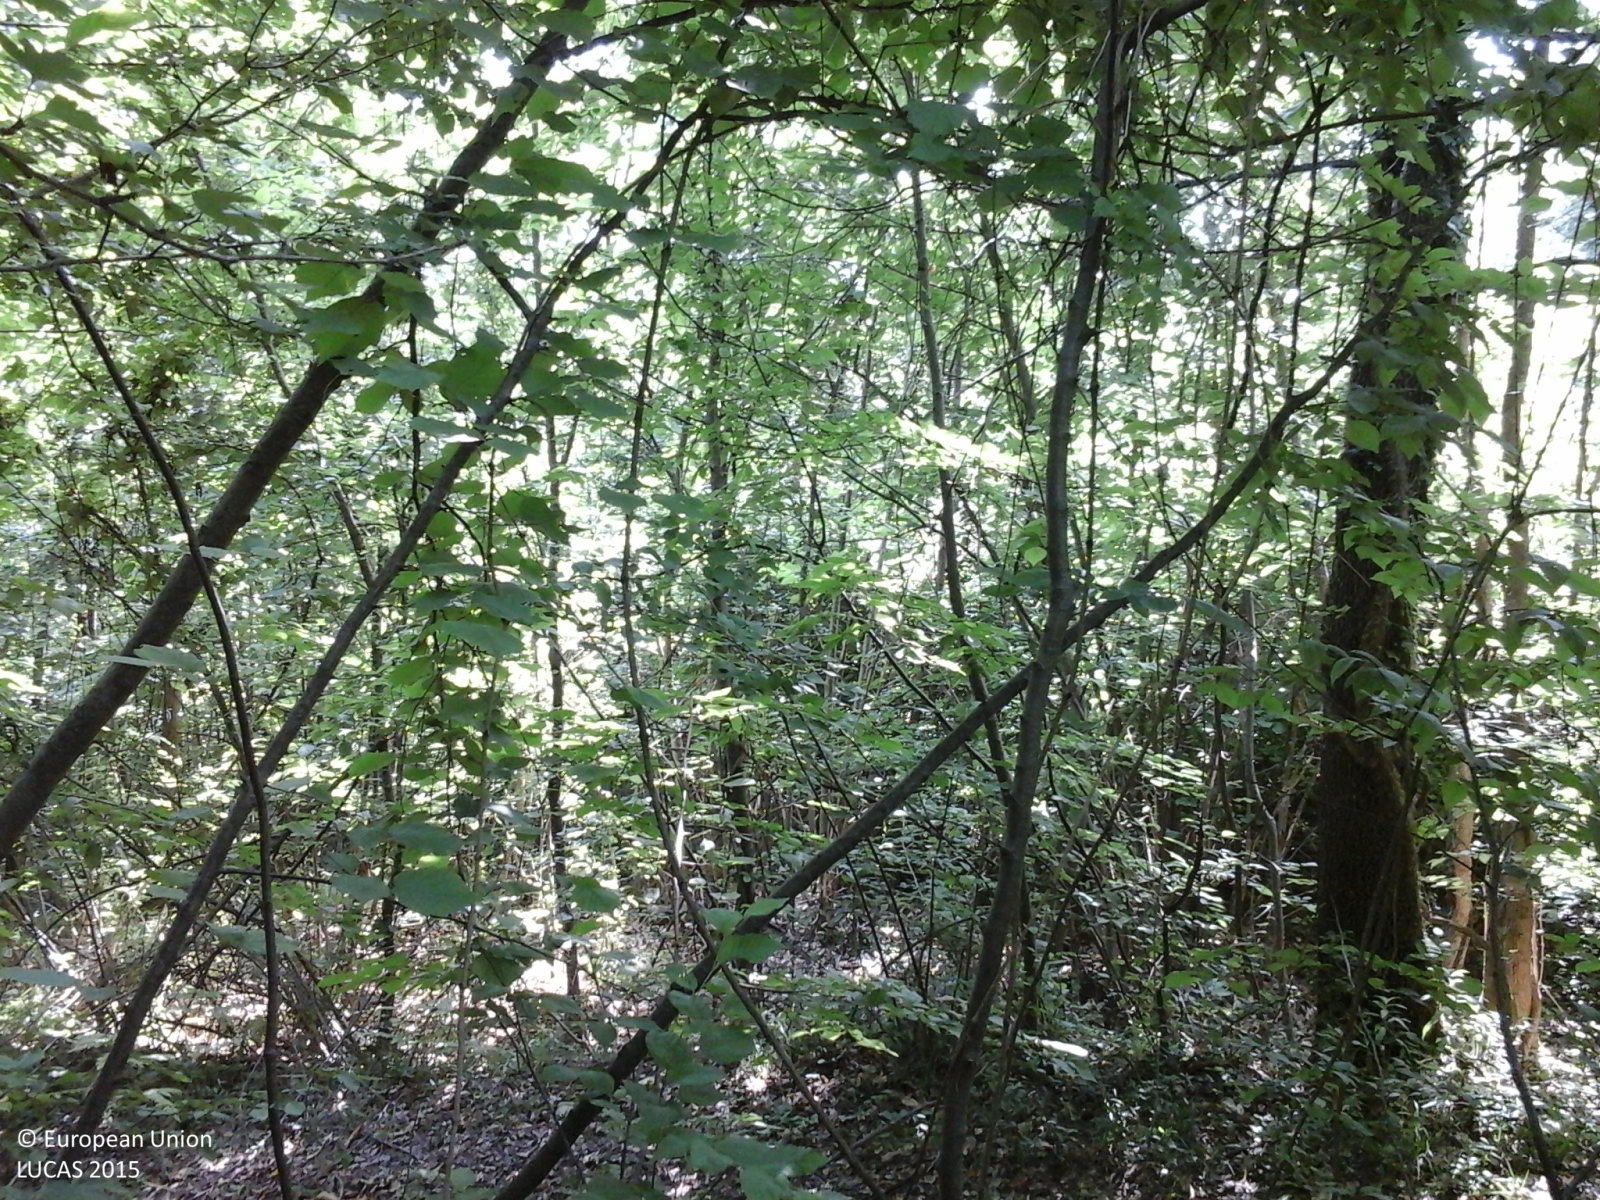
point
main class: Woodland
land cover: Broadleaved woodland
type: thermophilous deciduous forest
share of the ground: > 75 %
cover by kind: broadleaved forest trees 90 %, shrubs 5 %, herbaceous plants 5 %
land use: Semi-natural and natural areas not in use
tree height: > 5 m
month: June
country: IT
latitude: 44.5150
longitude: 8.1797
